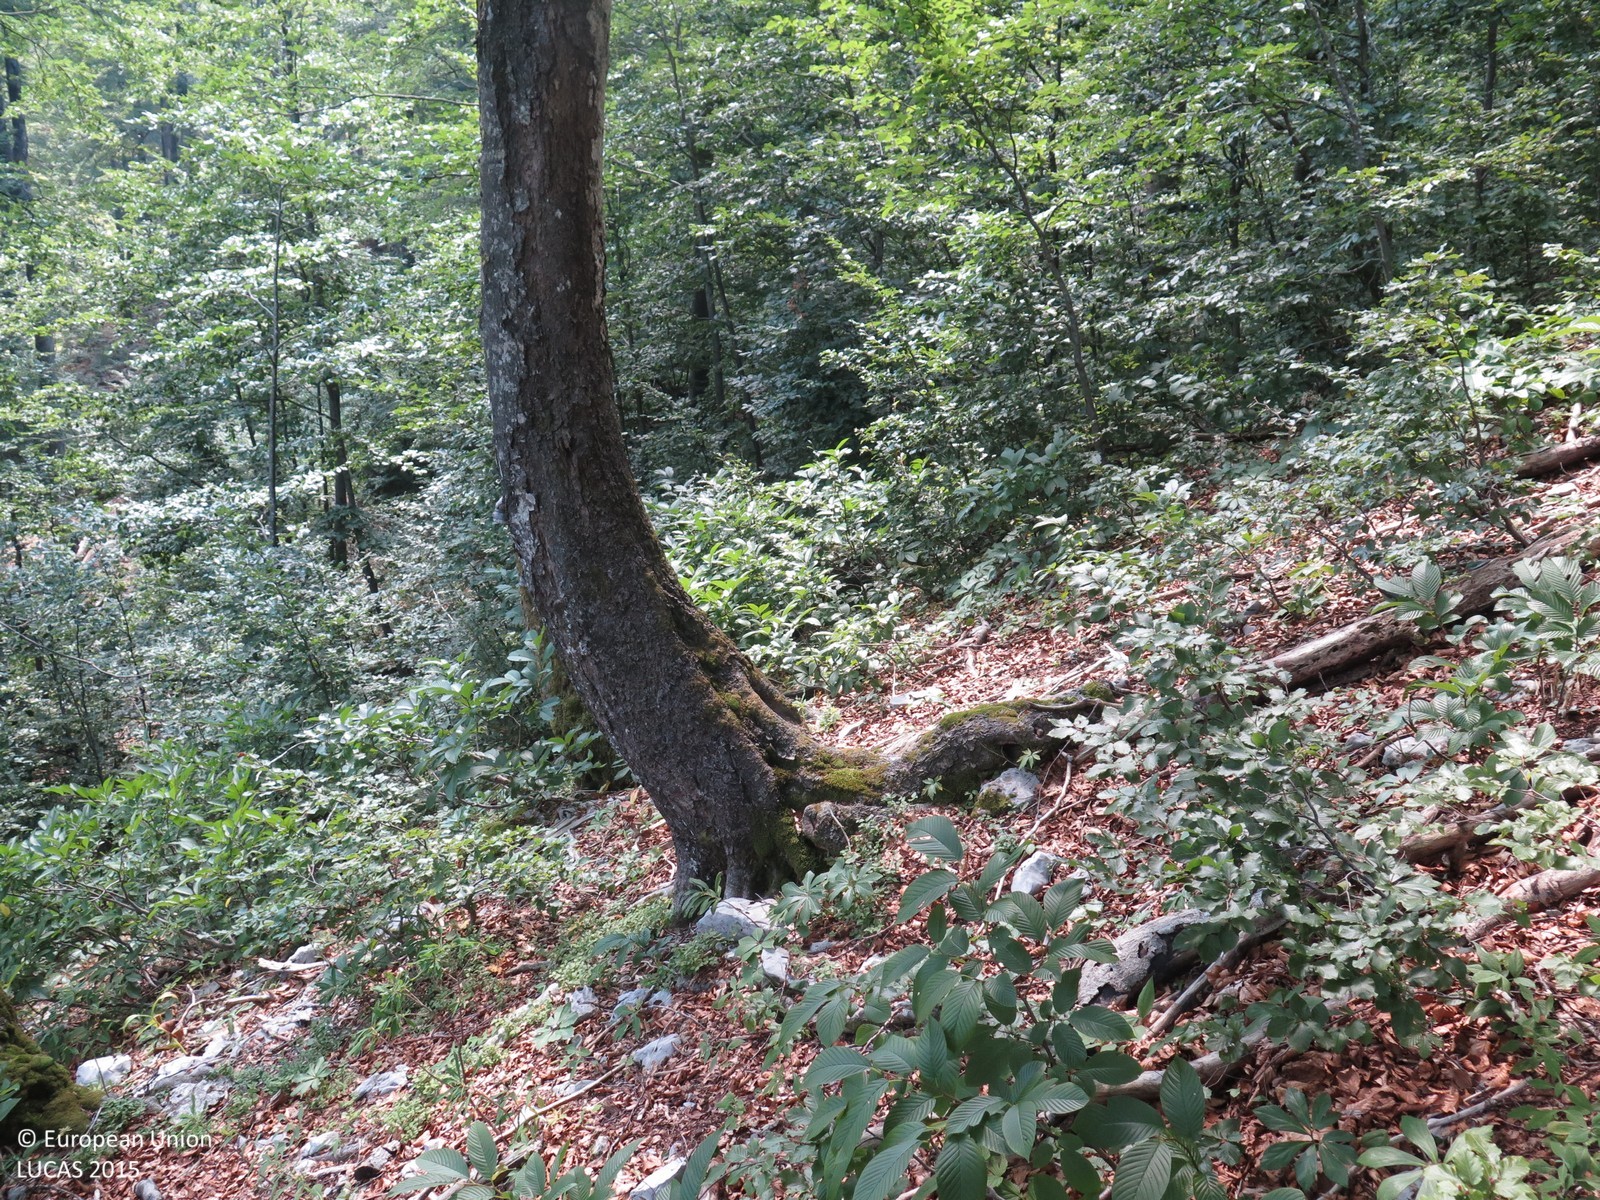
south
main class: Woodland
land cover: Other mixed woodland
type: mountainous beech forest
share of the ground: > 75 %
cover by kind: broadleaved forest trees 65 %, coniferous forest trees 25 %, shrubs 5 %, herbaceous plants 5 %
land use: Forestry
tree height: > 5 m
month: August
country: HR
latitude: 45.5151
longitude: 14.5398
